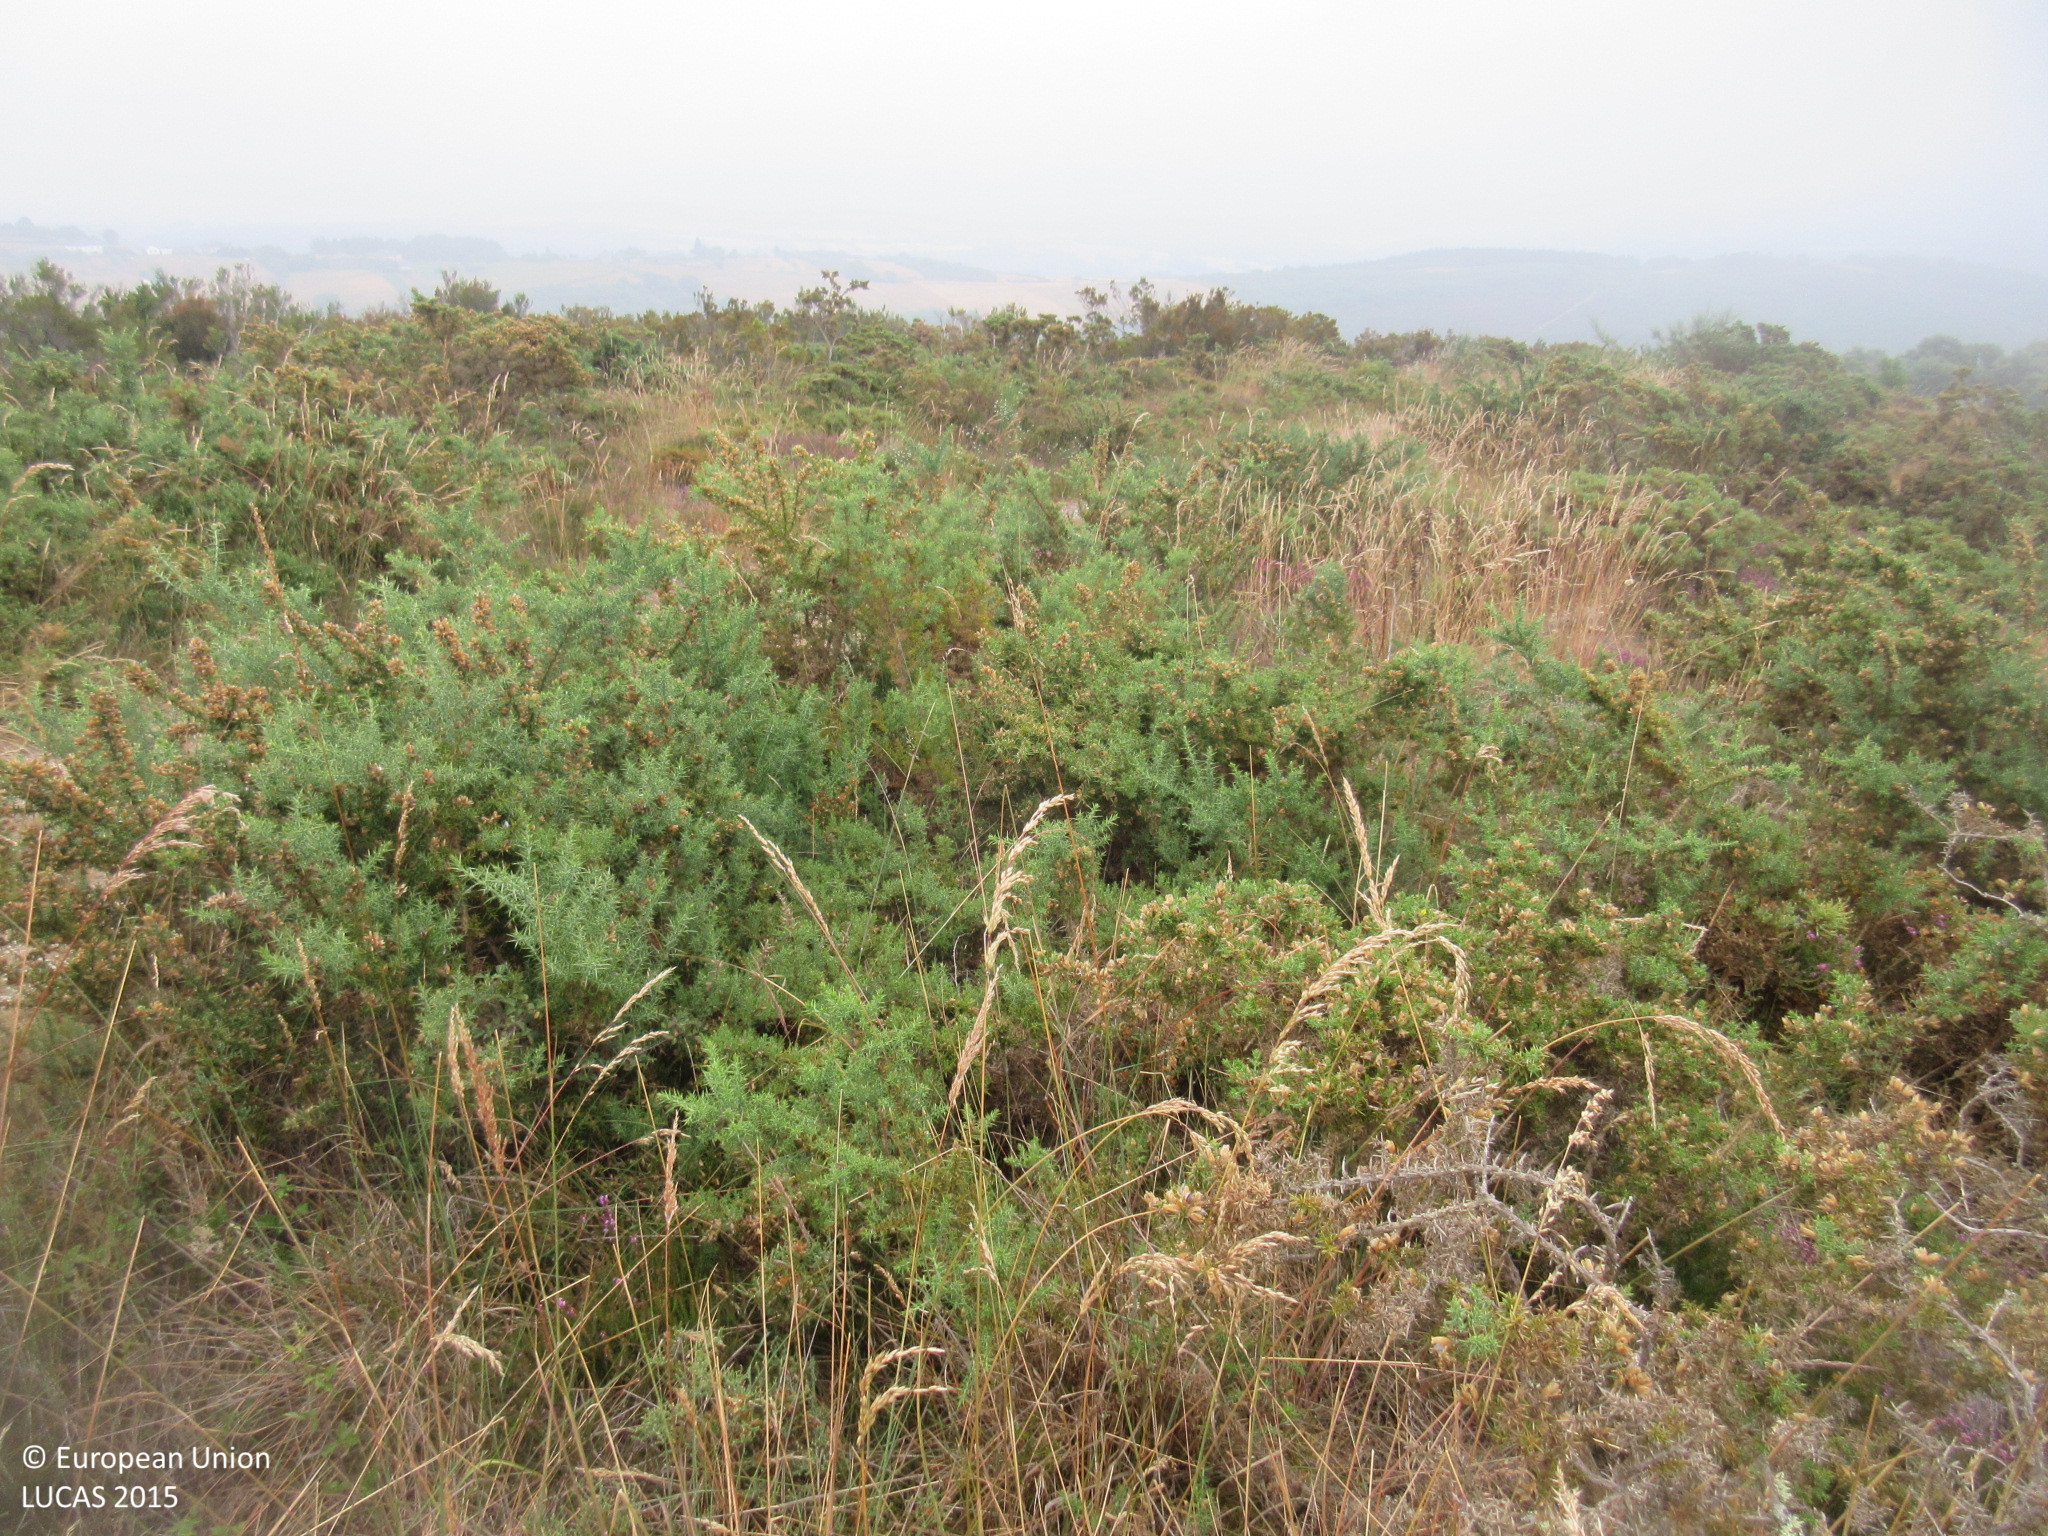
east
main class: Shrubland
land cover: Shrubland with sparse tree cover
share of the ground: > 75 %
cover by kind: shrubs 95 %, broadleaved forest trees 5 %
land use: Semi-natural and natural areas not in use
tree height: > 5 m
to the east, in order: Shrubland with sparse tree cover; Shrubland without tree cover; Tracks; Shrubland without tree cover
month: June
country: ES
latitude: 42.8959
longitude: -7.1228
